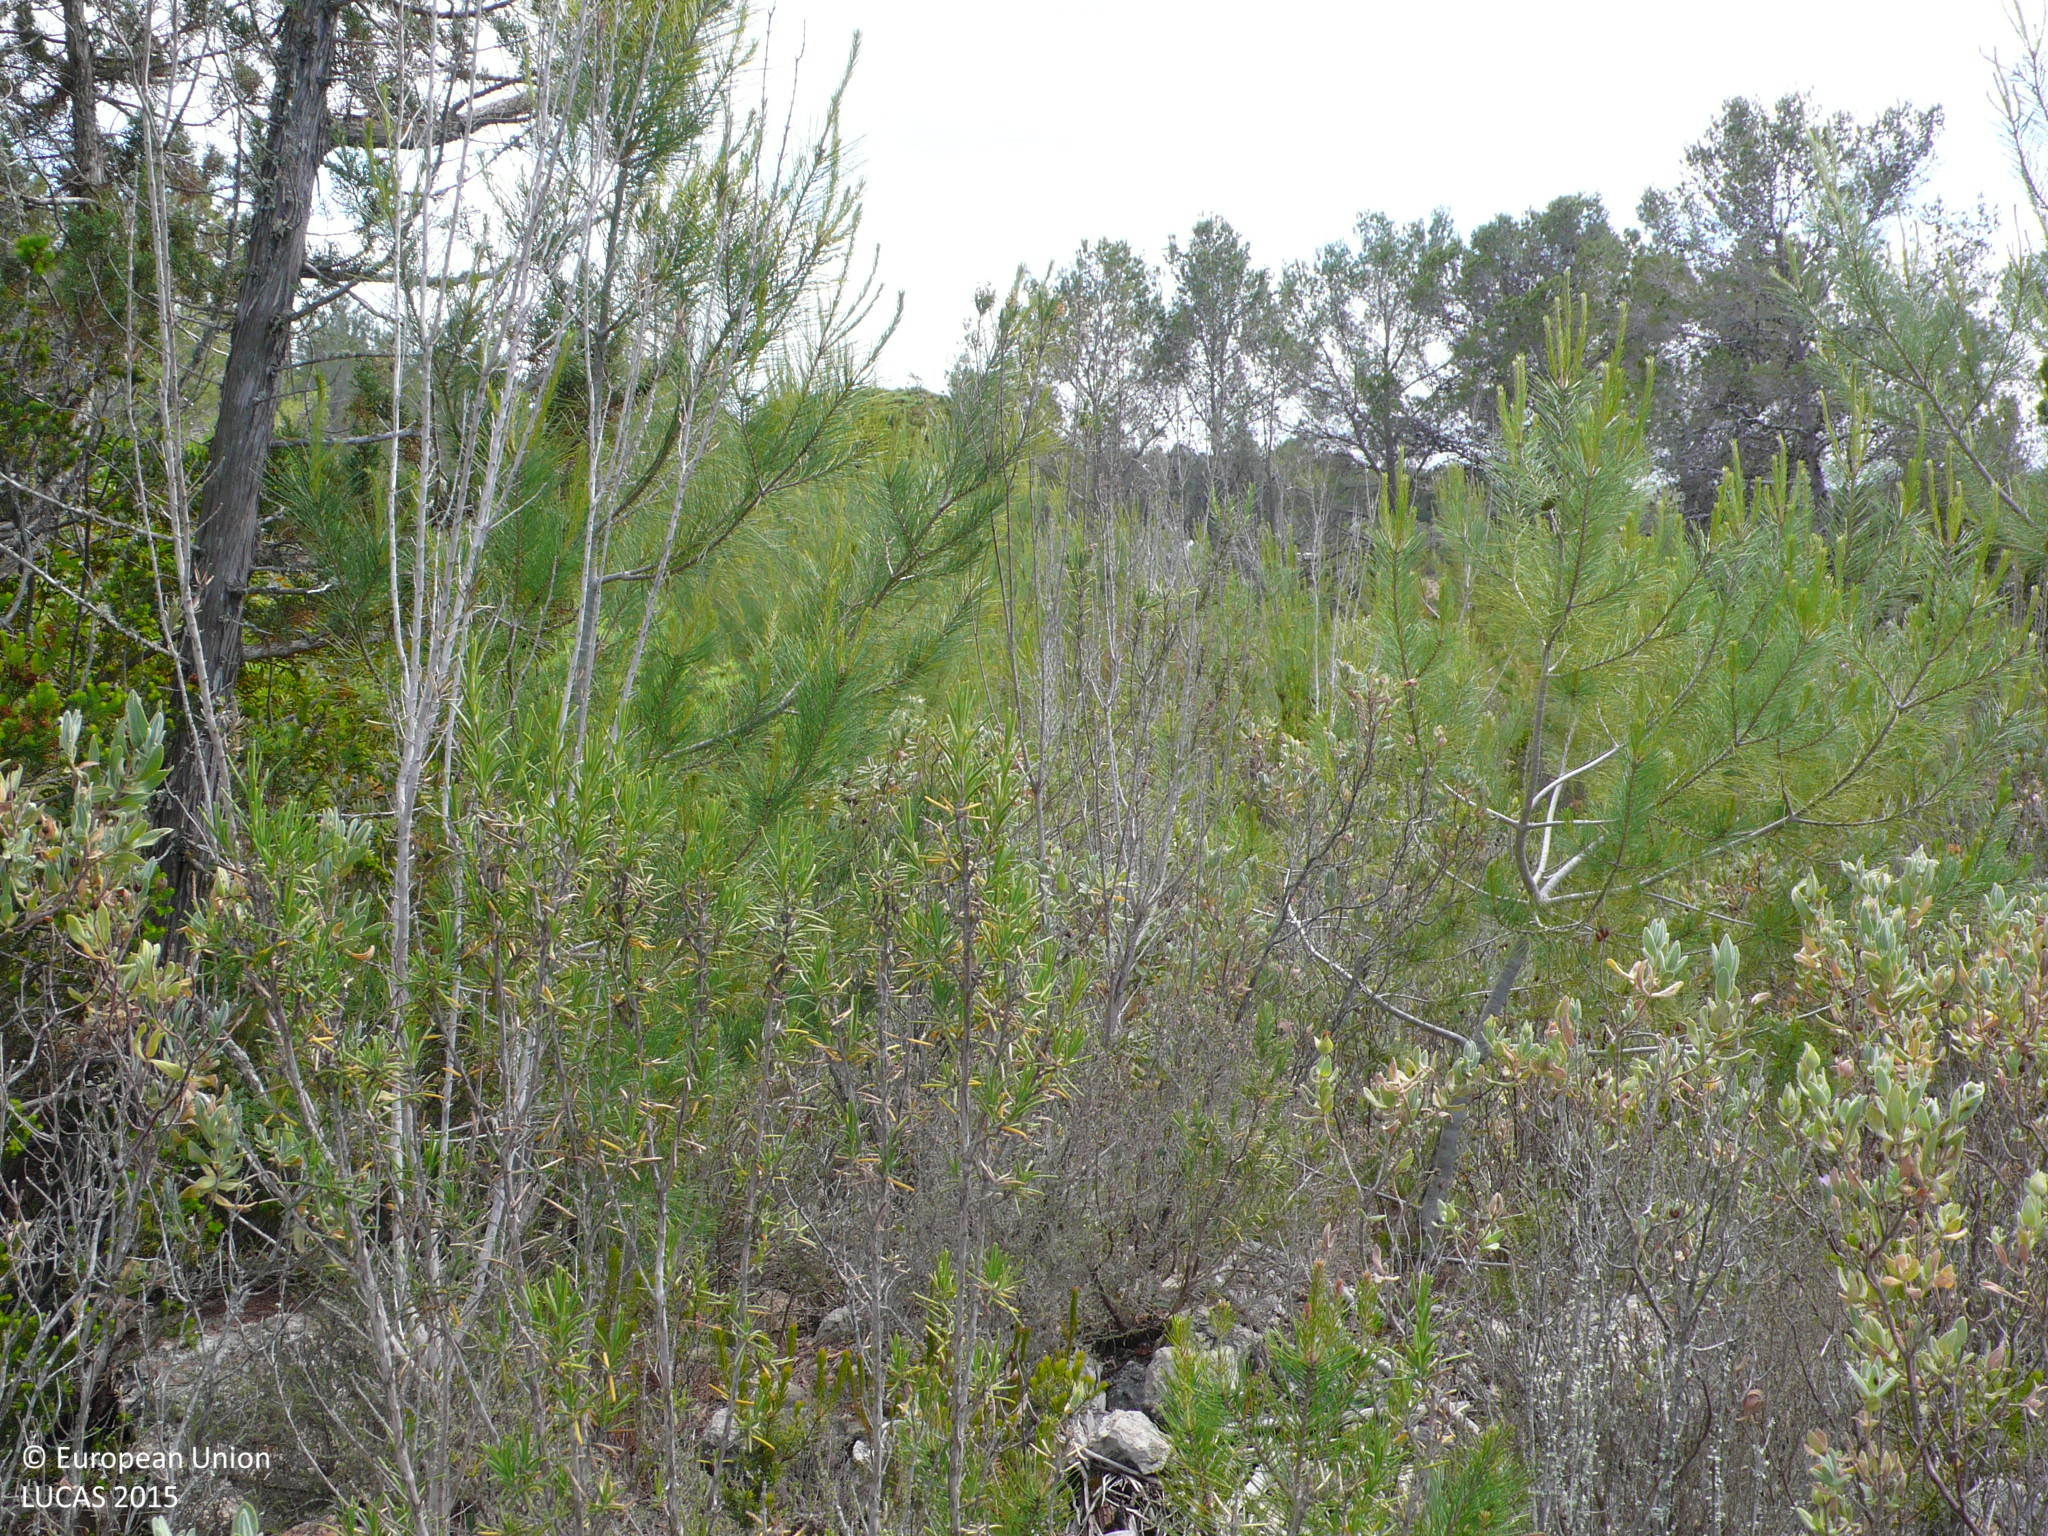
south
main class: Woodland
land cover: Pine dominated coniferous woodland
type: coniferous forest of the mediterranean region
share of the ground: 25 - 50 %
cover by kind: shrubs 60 %, coniferous forest trees 40 %
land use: Forestry
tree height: < 5 m
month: May
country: ES
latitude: 39.0763
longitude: 1.4691
